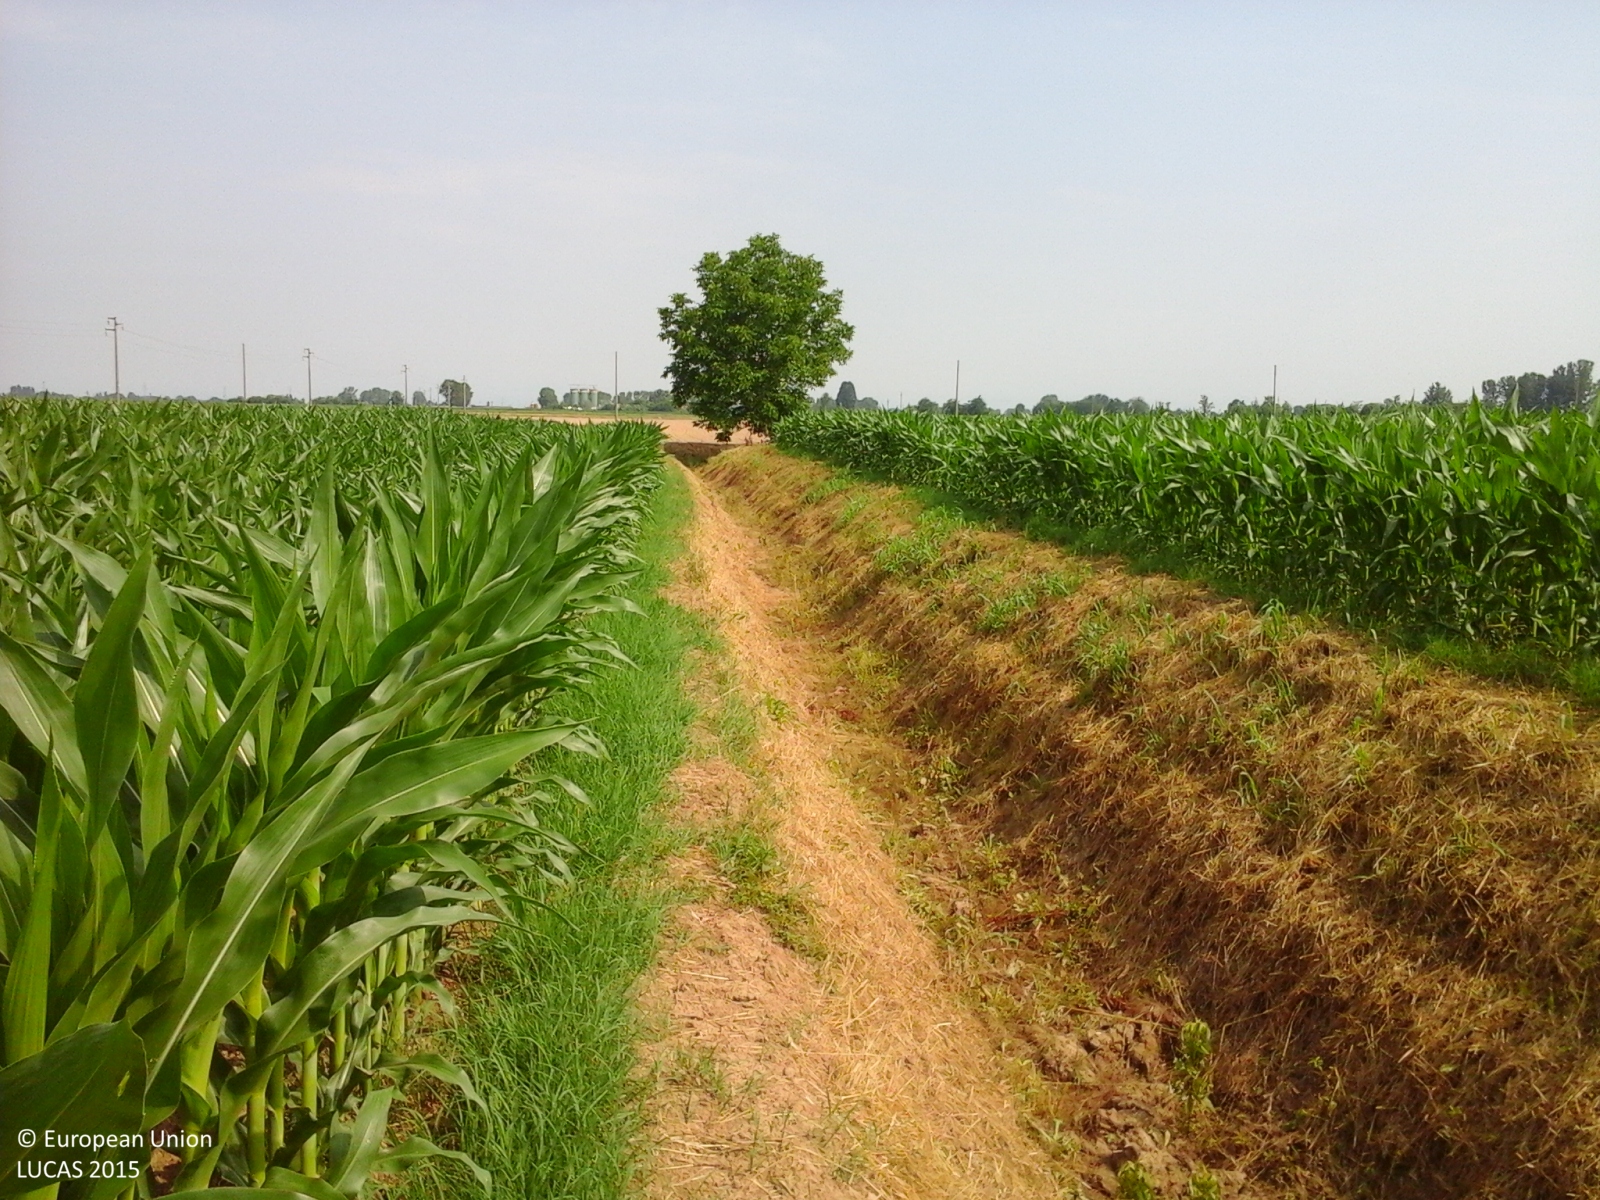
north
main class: Cropland
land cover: Maize
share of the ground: > 75 %
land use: Agriculture (excluding fallow land and kitchen gardens)
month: June
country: IT
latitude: 45.3057
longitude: 9.6817
